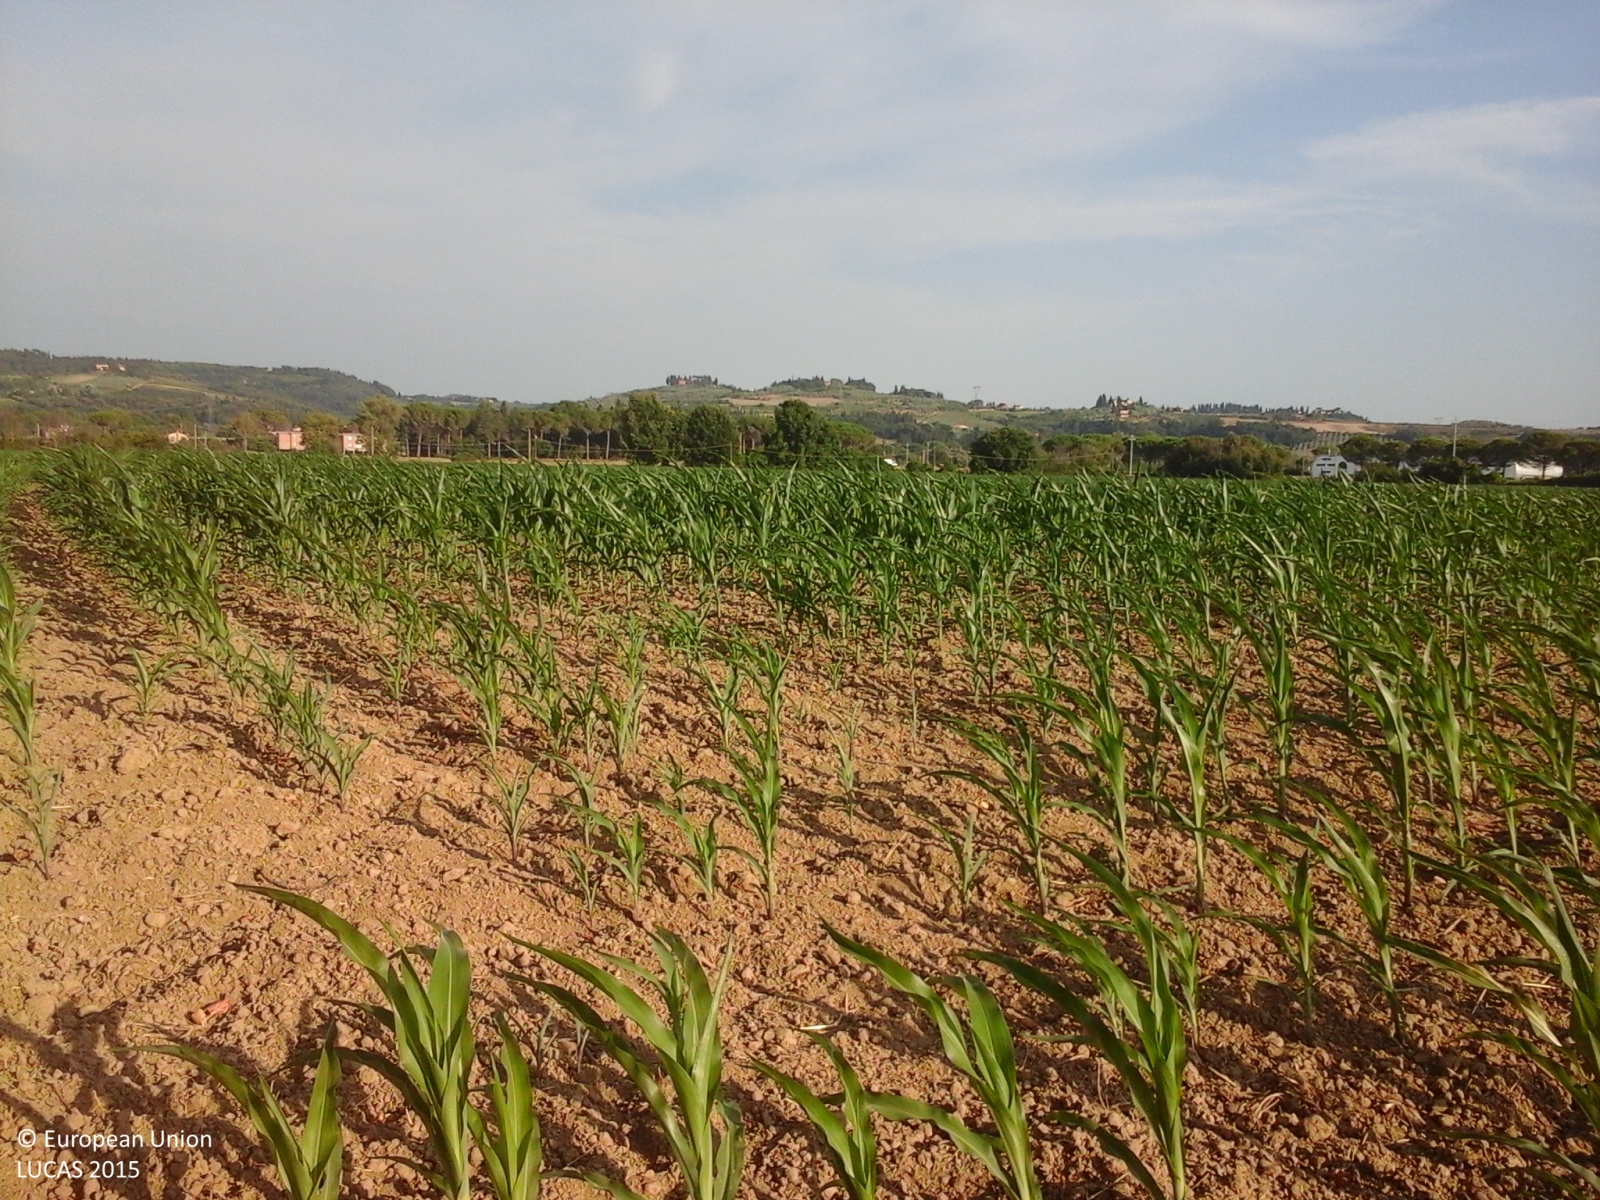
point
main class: Cropland
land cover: Maize
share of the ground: > 75 %
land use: Agriculture (excluding fallow land and kitchen gardens)
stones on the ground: < 10 %
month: July
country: IT
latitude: 43.7145
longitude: 10.9779
